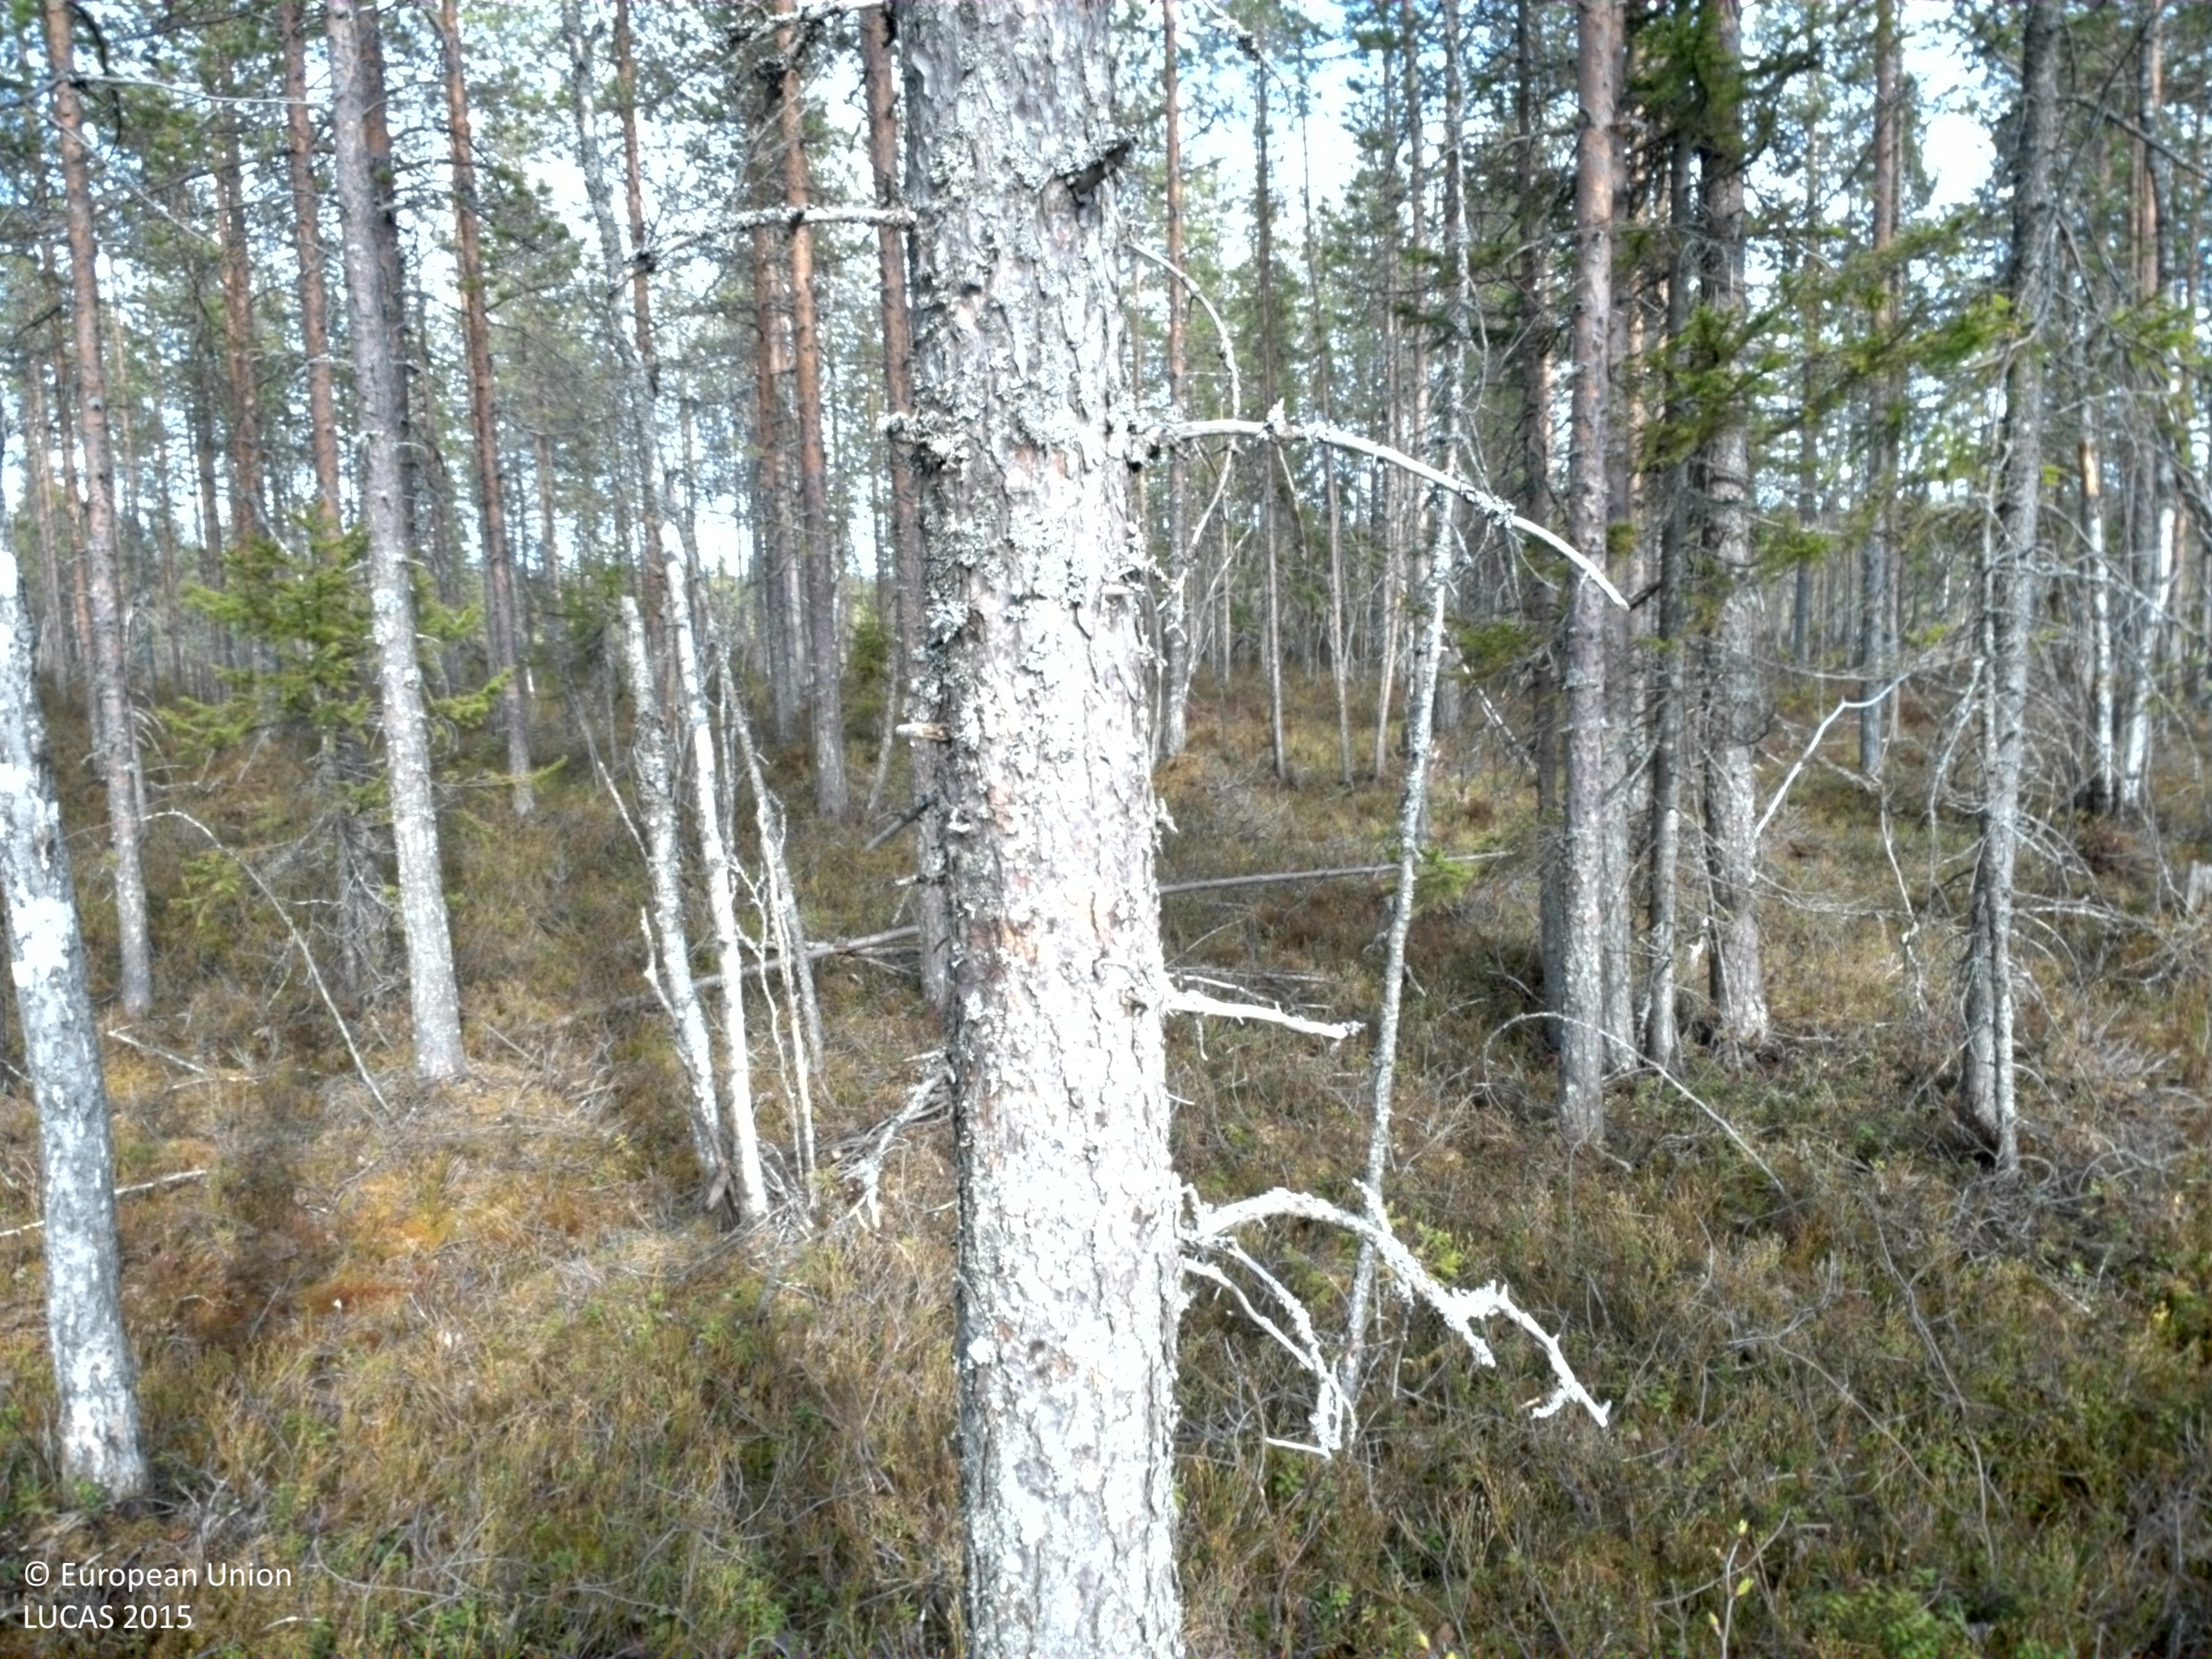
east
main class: Woodland
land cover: Pine dominated coniferous woodland
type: boreal forest
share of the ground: > 75 %
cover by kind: coniferous forest trees 80 %, shrubs 20 %
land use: Forestry
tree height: > 5 m
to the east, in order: Pine dominated coniferous woodland; Pine dominated mixed woodland
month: May
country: SE
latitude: 65.9720
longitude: 23.7061
